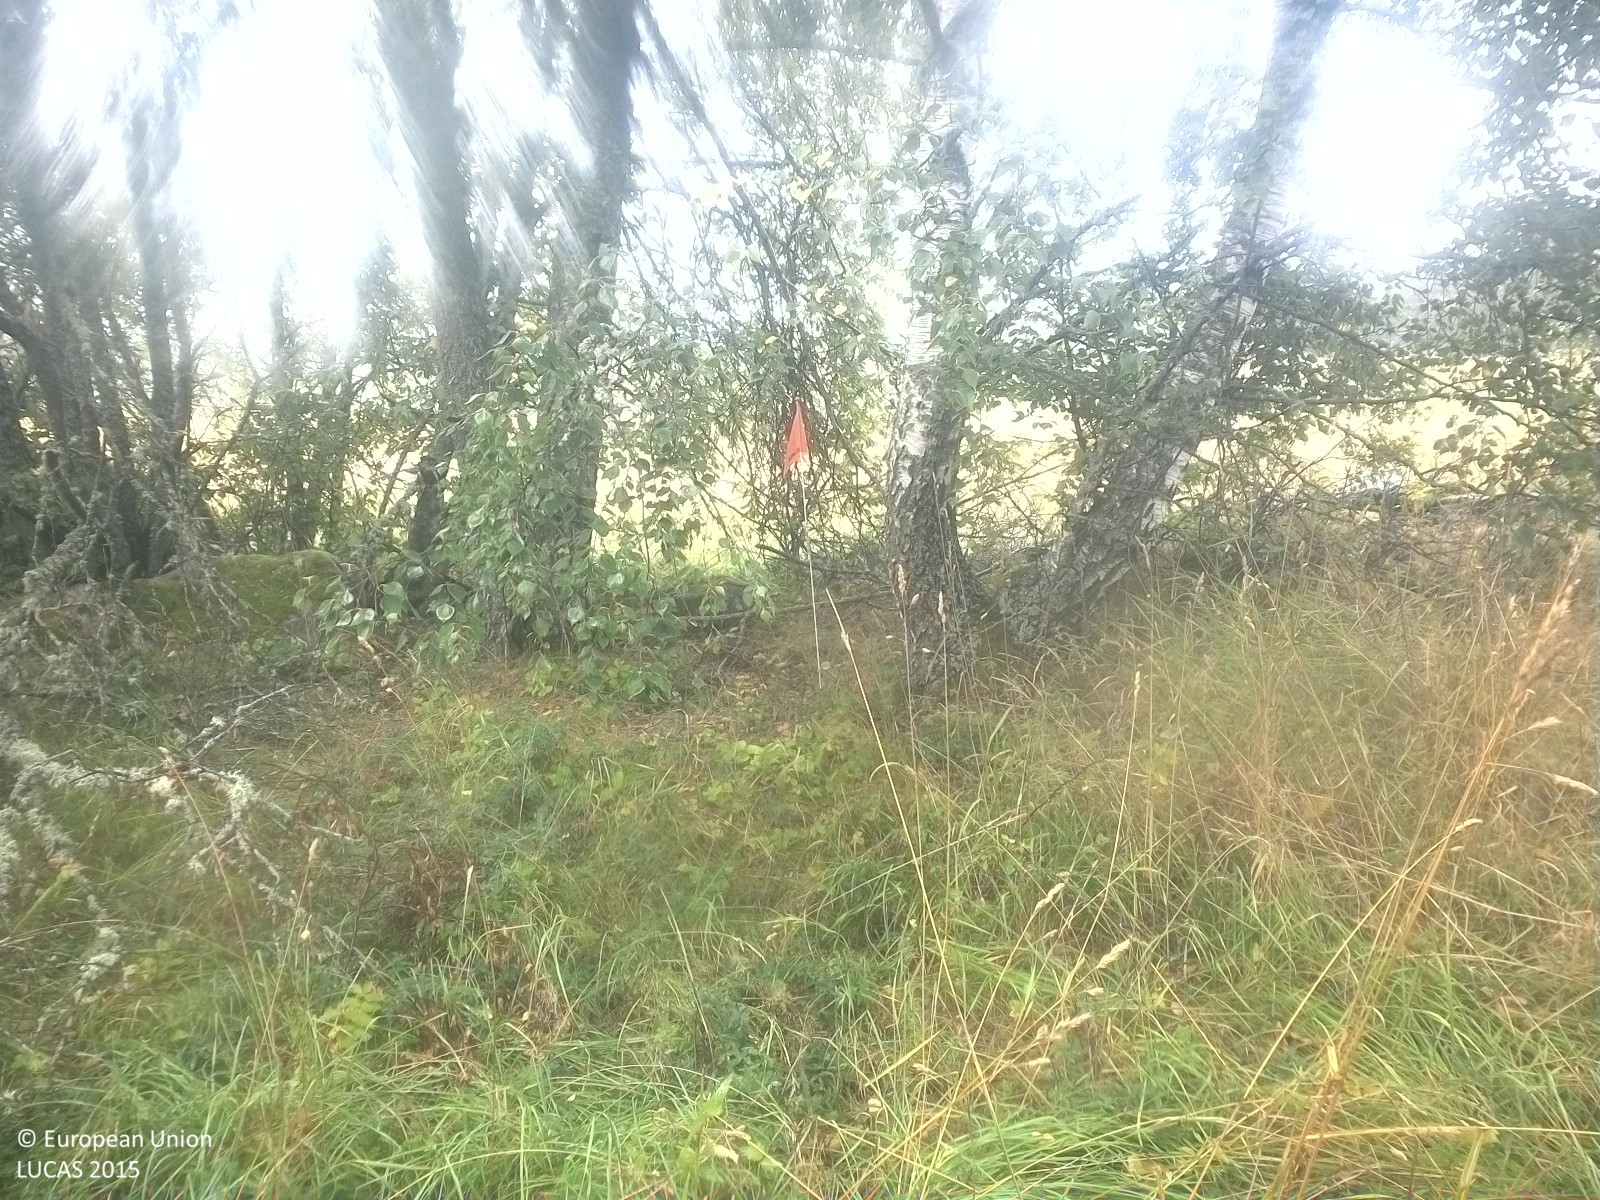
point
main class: Woodland
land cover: Broadleaved woodland
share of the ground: 50 - 75 %
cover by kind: broadleaved forest trees 60 %, herbaceous plants 30 %, shrubs 5 %, lichens and mosses 5 %
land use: Agriculture (excluding fallow land and kitchen gardens)
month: September
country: SE
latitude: 59.4061
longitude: 15.9283
